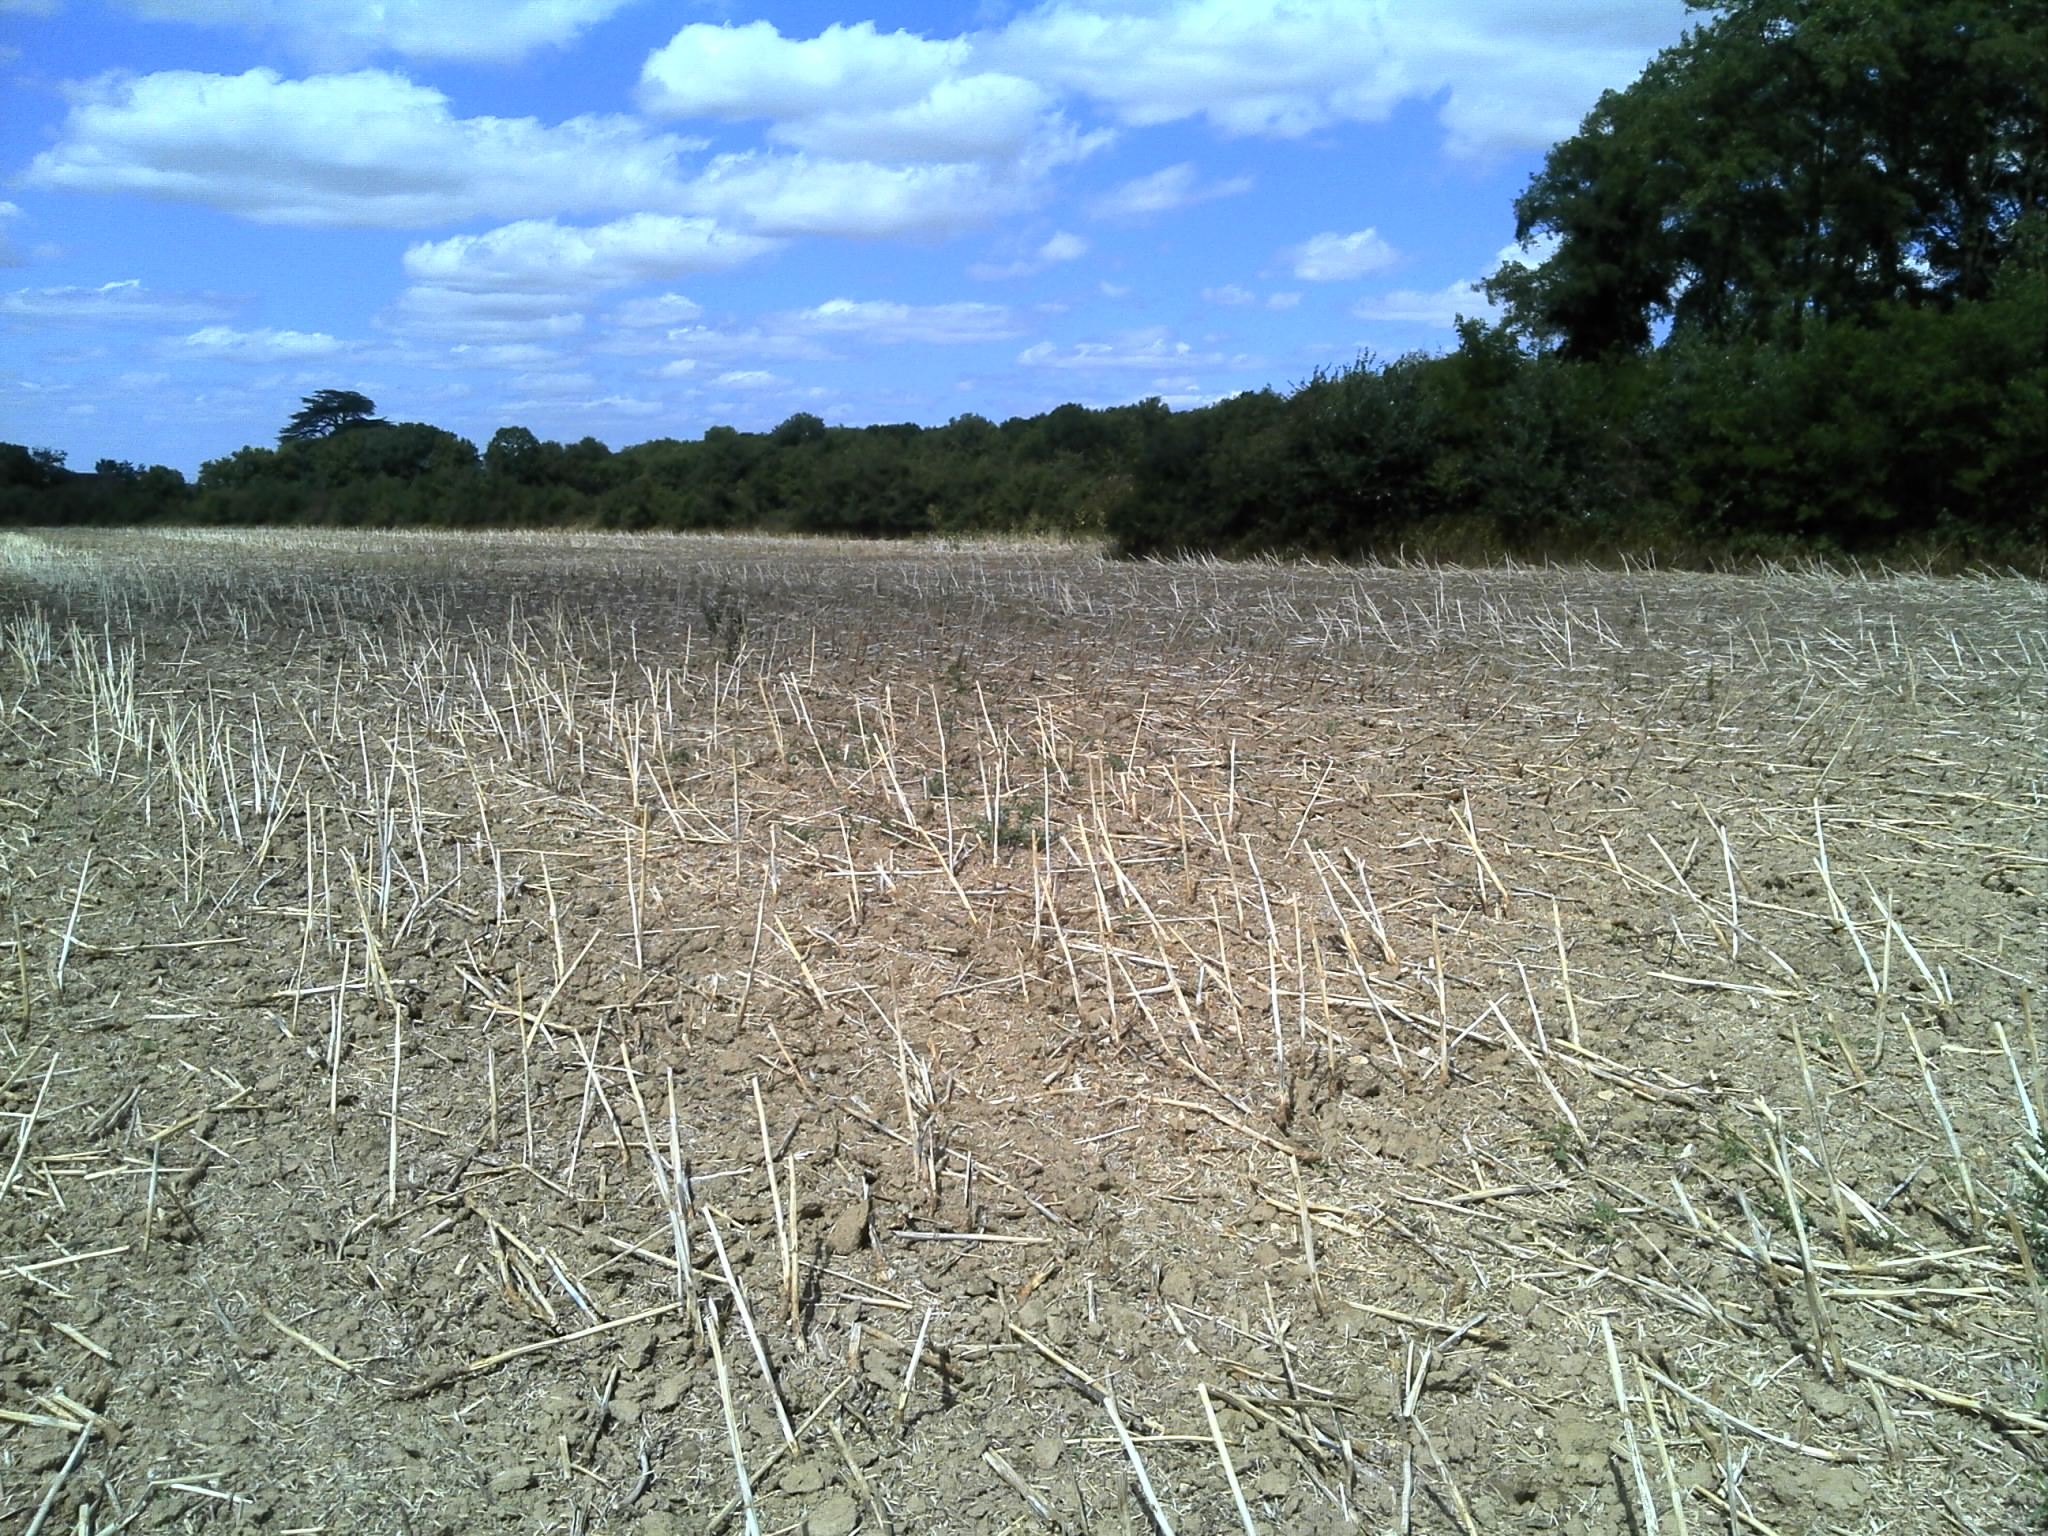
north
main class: Cropland
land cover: Rape and turnip rape
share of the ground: < 10 %
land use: Agriculture (excluding fallow land and kitchen gardens)
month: August
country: FR
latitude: 46.8557
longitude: 1.6344
